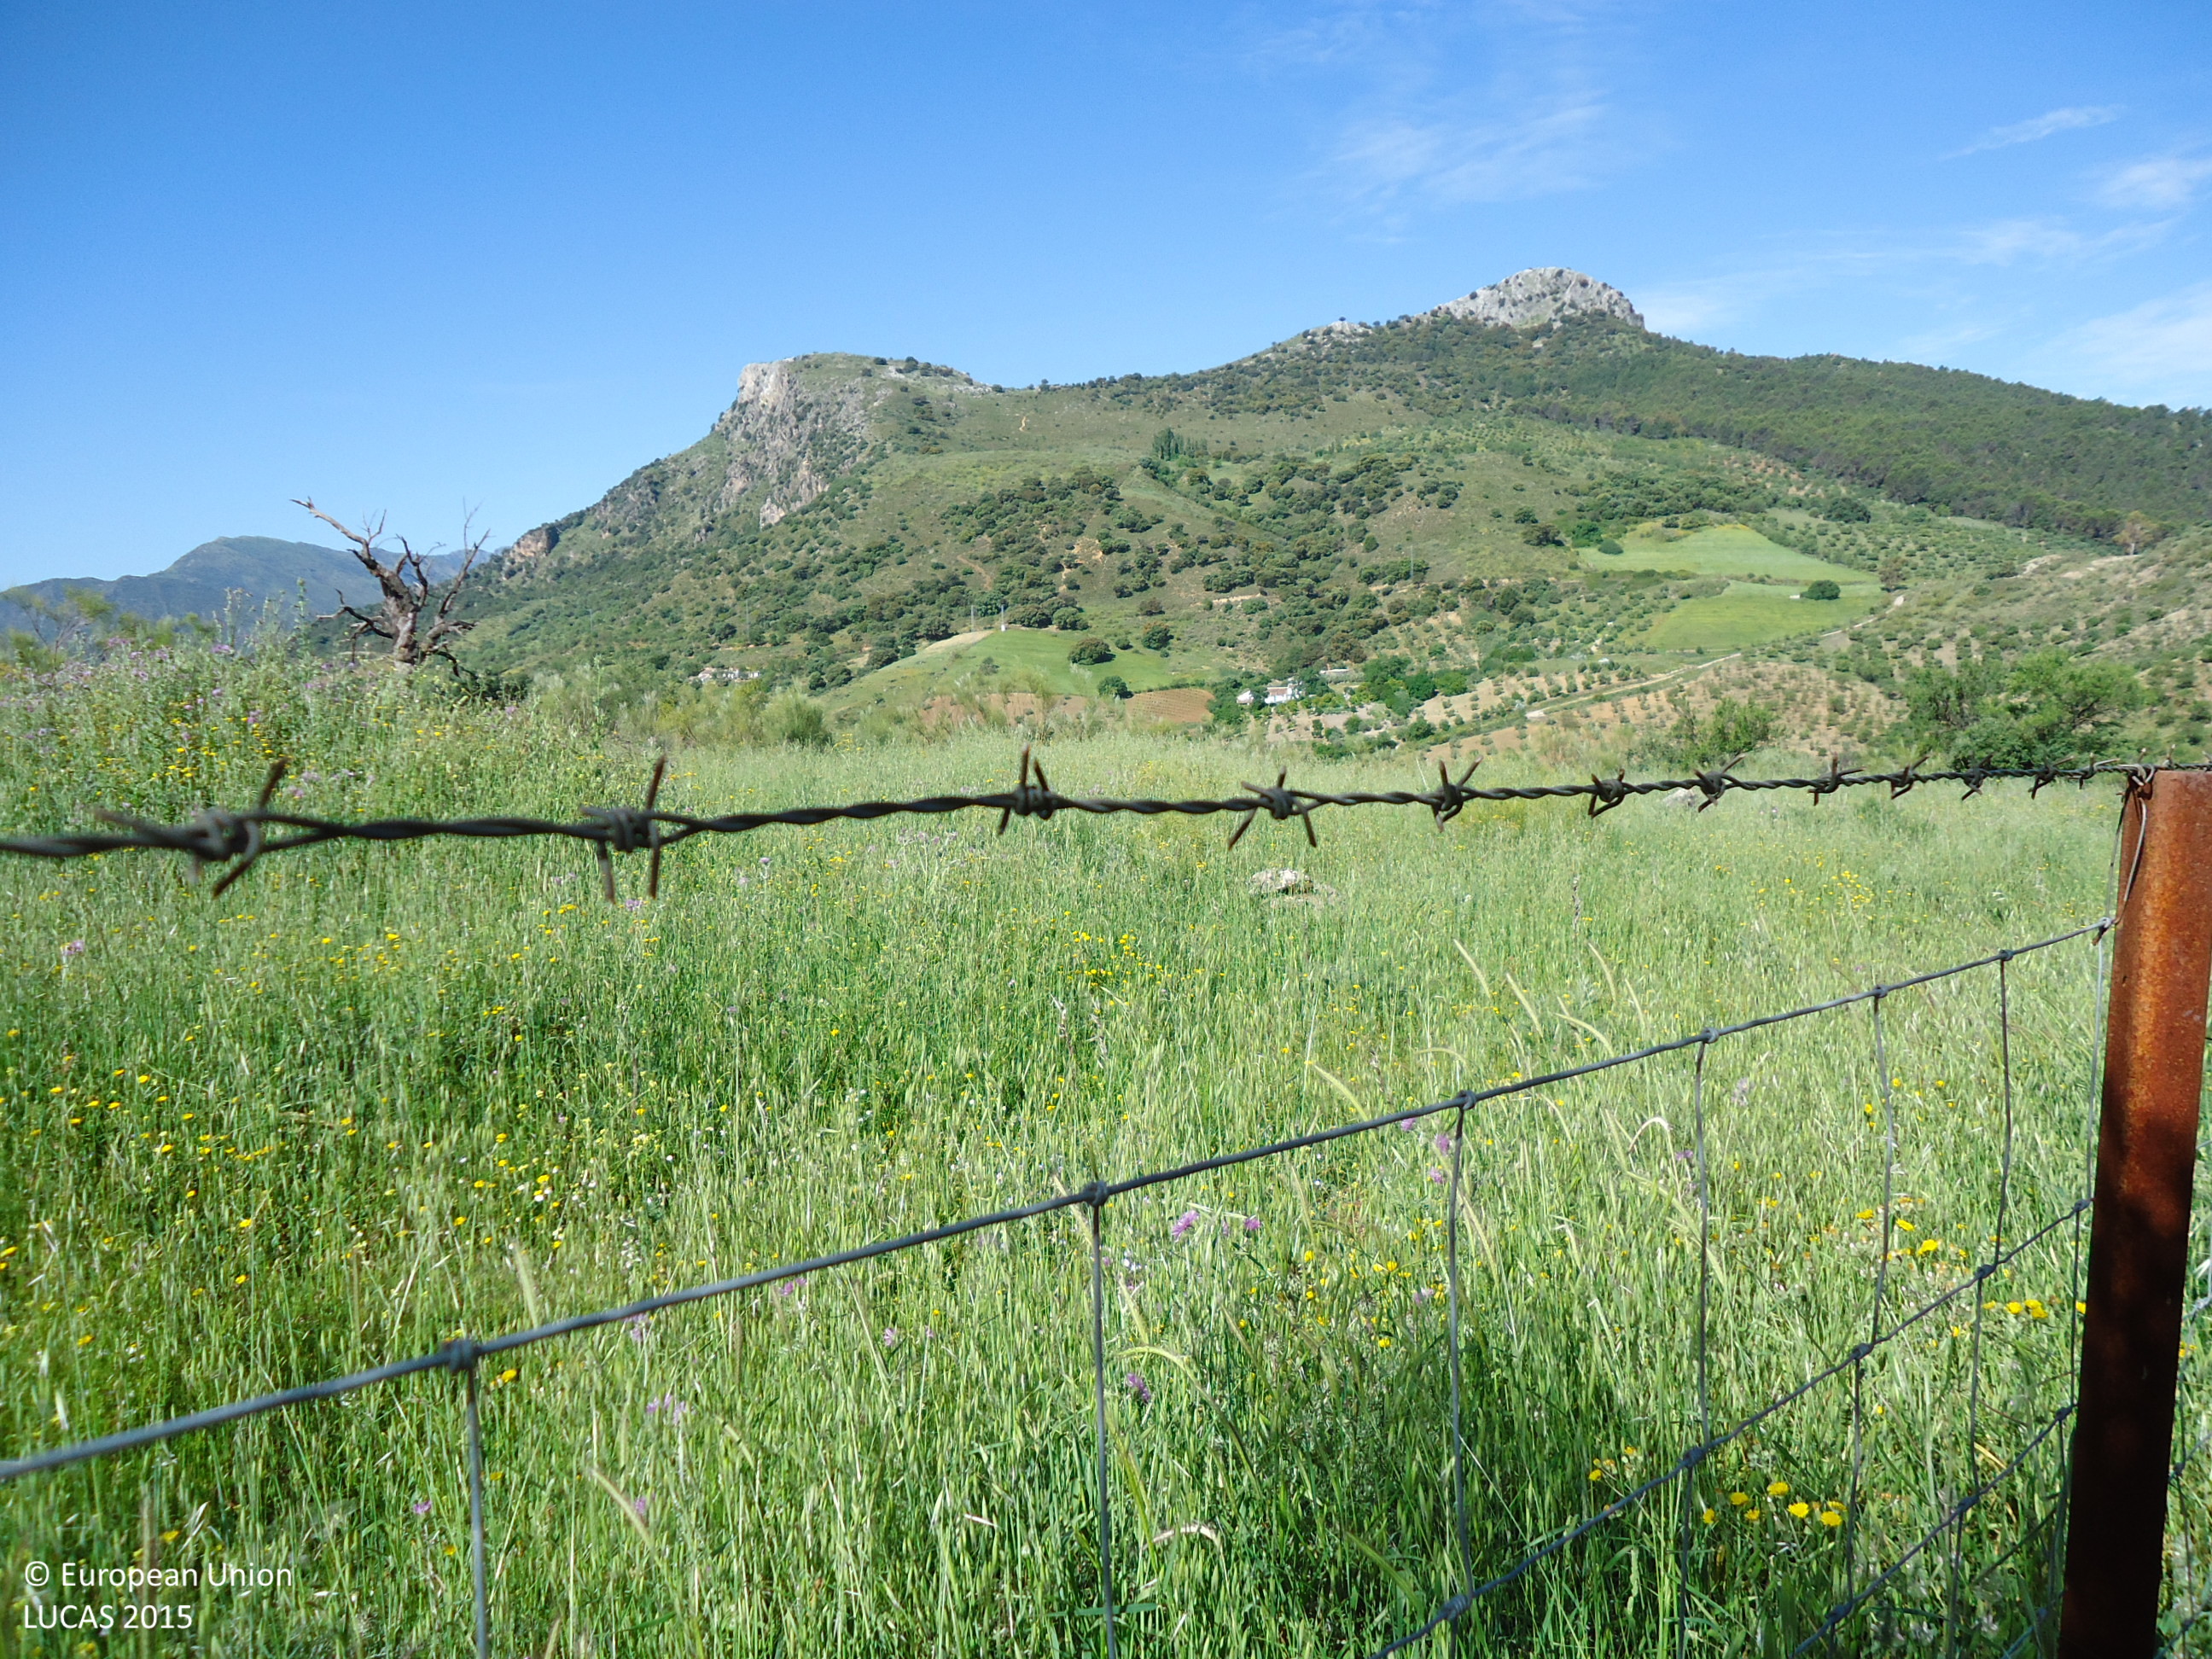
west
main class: Cropland
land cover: Mixed cereals for fodder
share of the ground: > 75 %
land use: Agriculture (excluding fallow land and kitchen gardens)
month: May
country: ES
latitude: 36.8495
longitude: -5.3116
